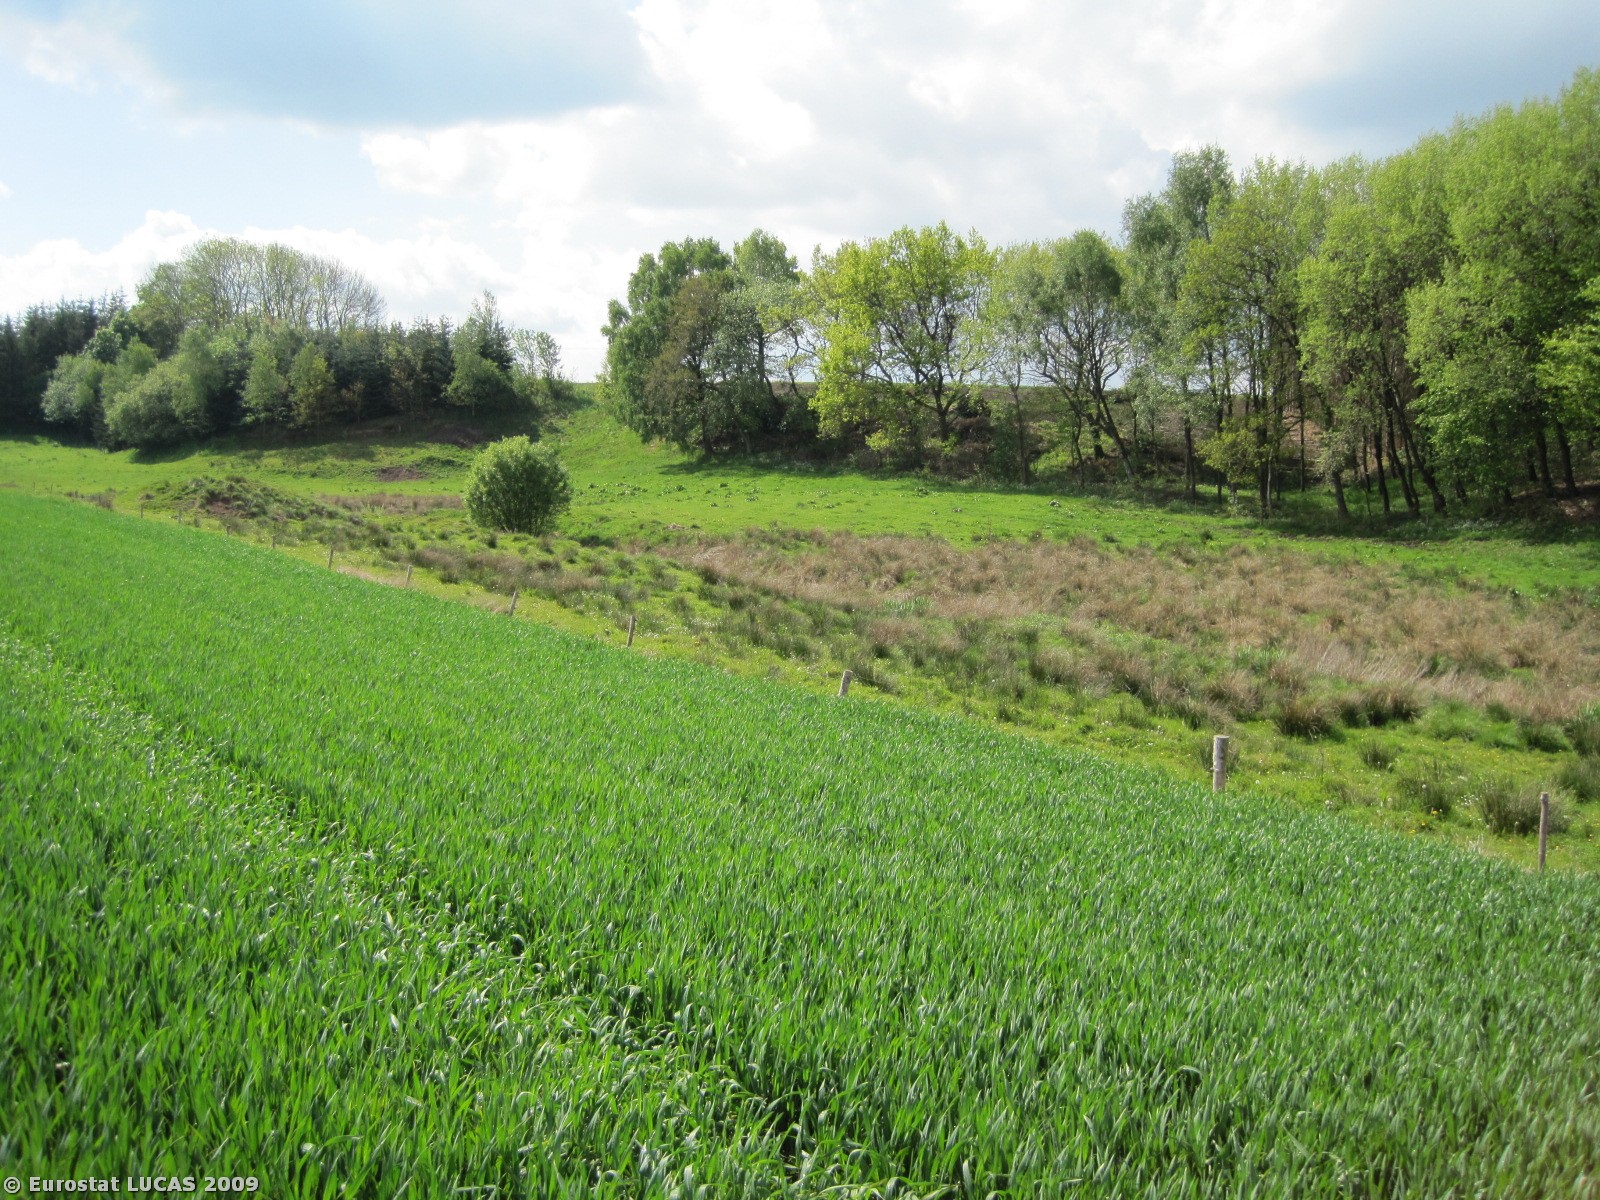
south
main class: Cropland
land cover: Common wheat
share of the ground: > 75 %
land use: Agriculture (excluding fallow land and kitchen gardens)
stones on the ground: < 10 %
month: May
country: DK
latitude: 56.3133
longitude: 9.7255
